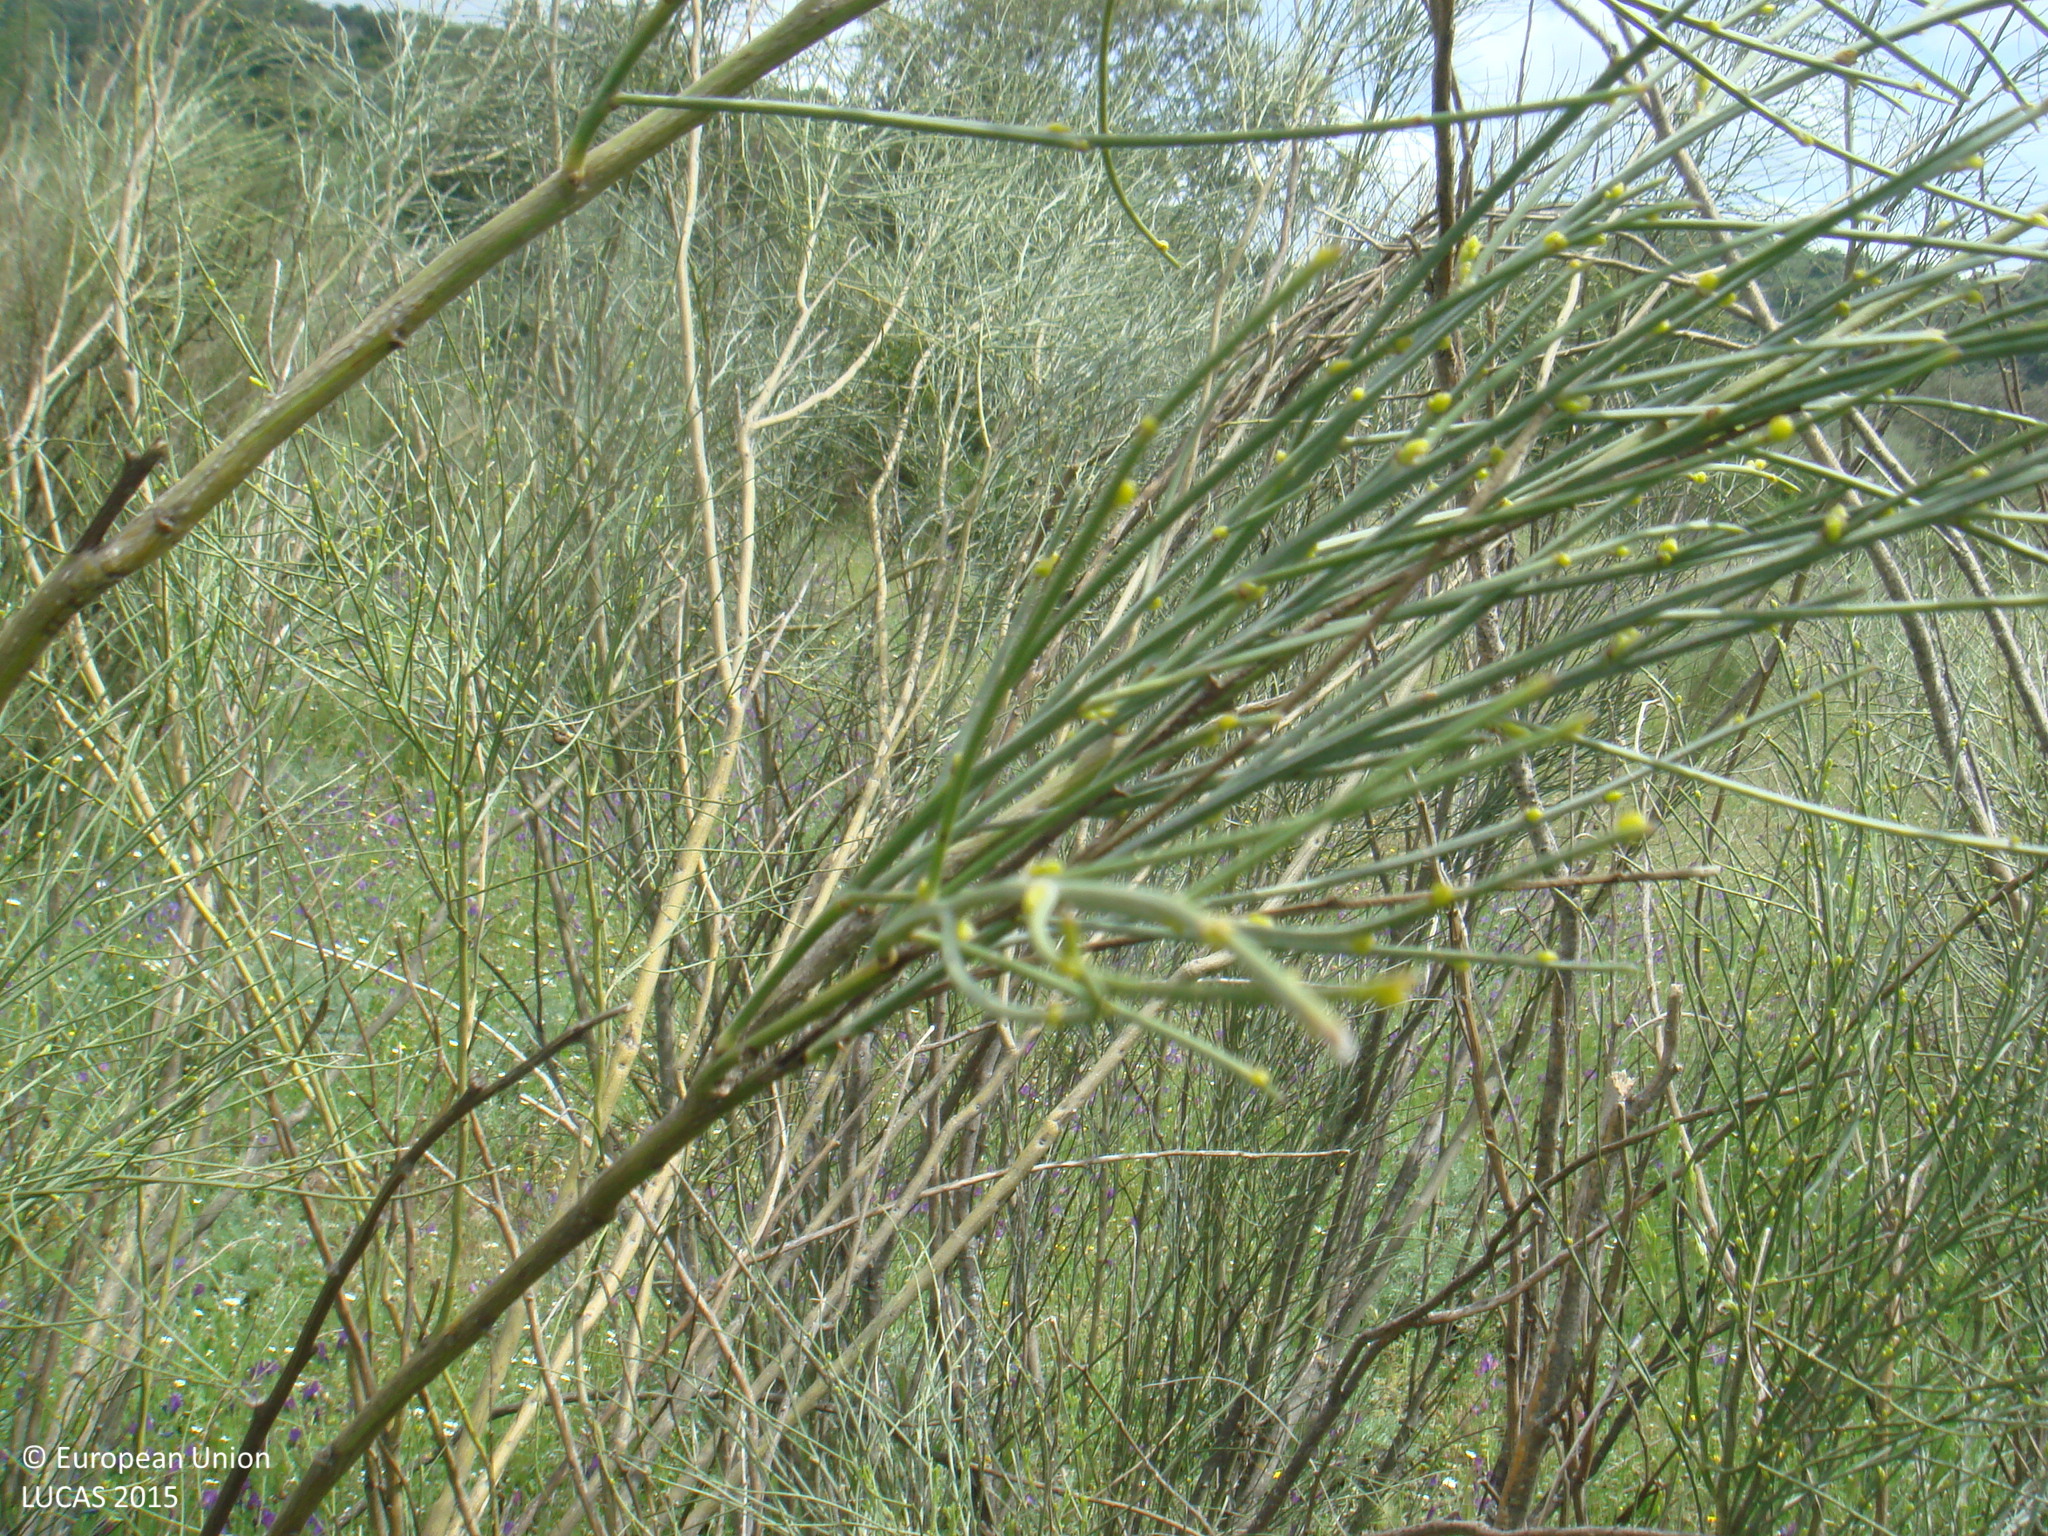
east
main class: Shrubland
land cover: Shrubland with sparse tree cover
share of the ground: 25 - 50 %
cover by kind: herbaceous plants 55 %, shrubs 40 %, broadleaved forest trees 5 %
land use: Semi-natural and natural areas not in use
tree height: > 5 m
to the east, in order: Shrubland with sparse tree cover; Fences; Abandoned hedges; Olive groves; Fences; Shrubland with sparse tree cover
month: April
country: ES
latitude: 38.2178
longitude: -5.0434
